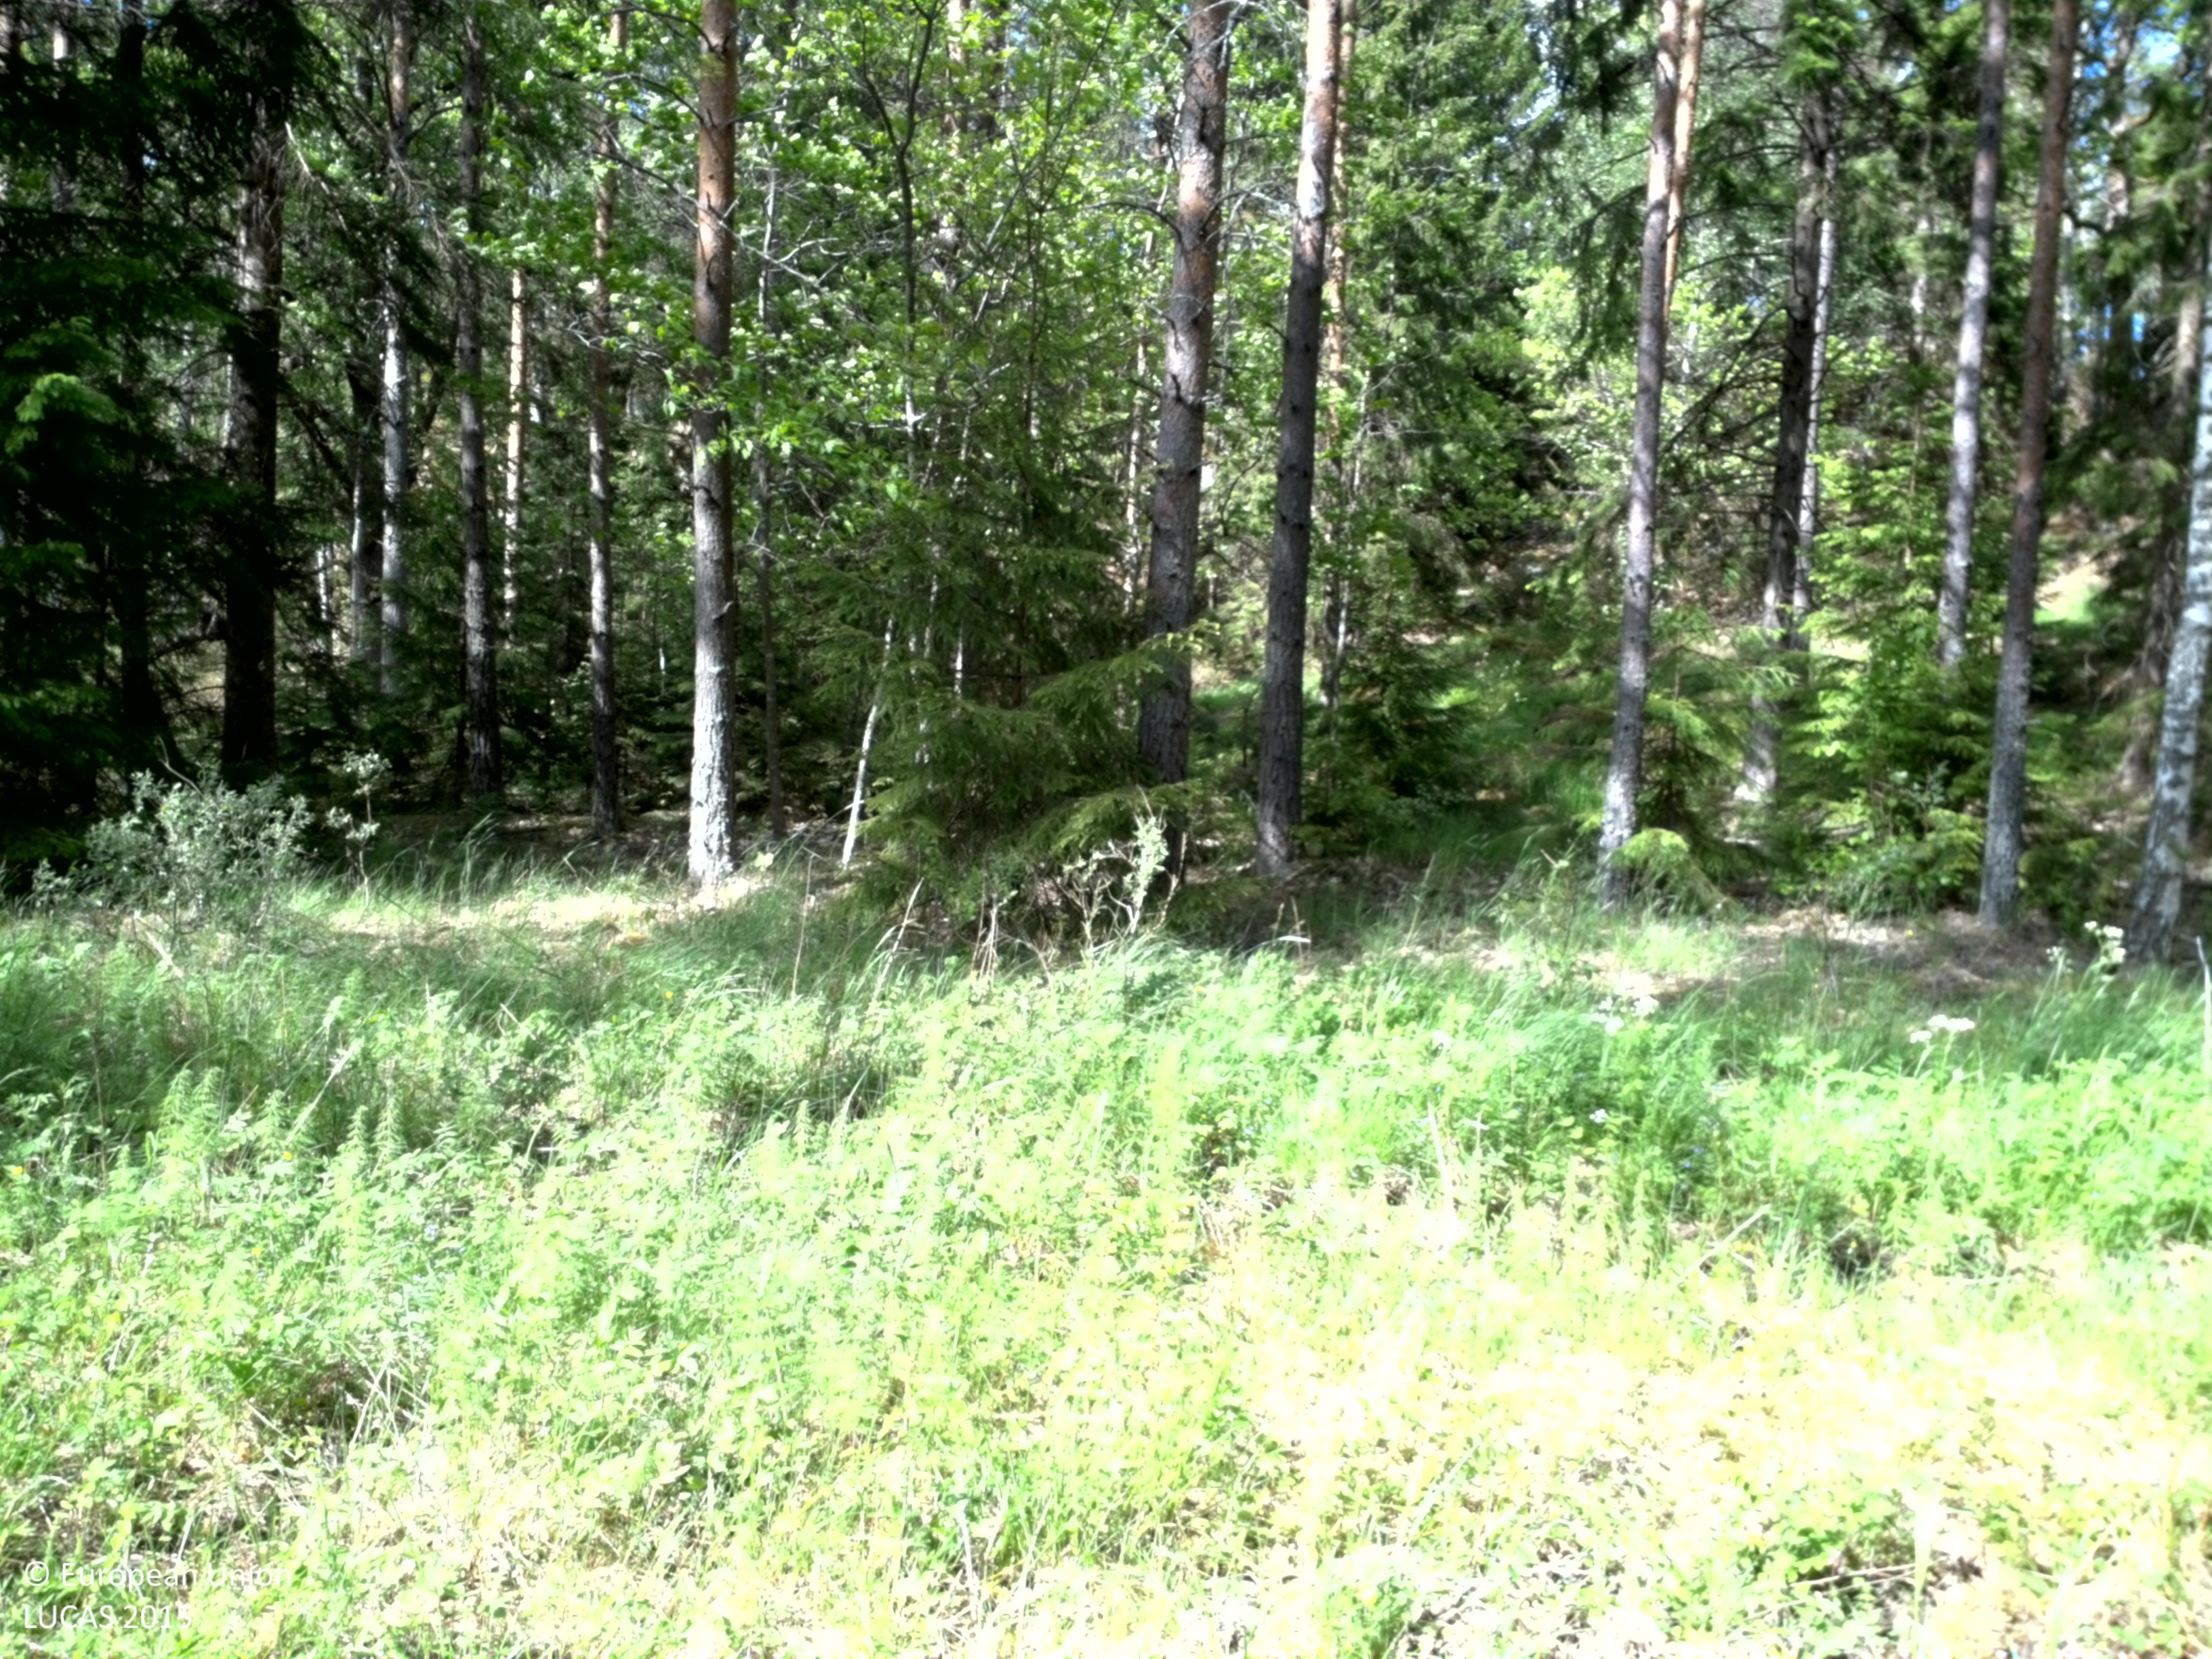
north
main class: Woodland
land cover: Spruce dominated coniferous woodland
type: boreal forest
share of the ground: 50 - 75 %
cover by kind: coniferous forest trees 50 %, lichens and mosses 35 %, herbaceous plants 10 %, broadleaved forest trees 5 %
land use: Forestry
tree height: > 5 m
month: June
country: SE
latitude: 58.4173
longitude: 16.2442
